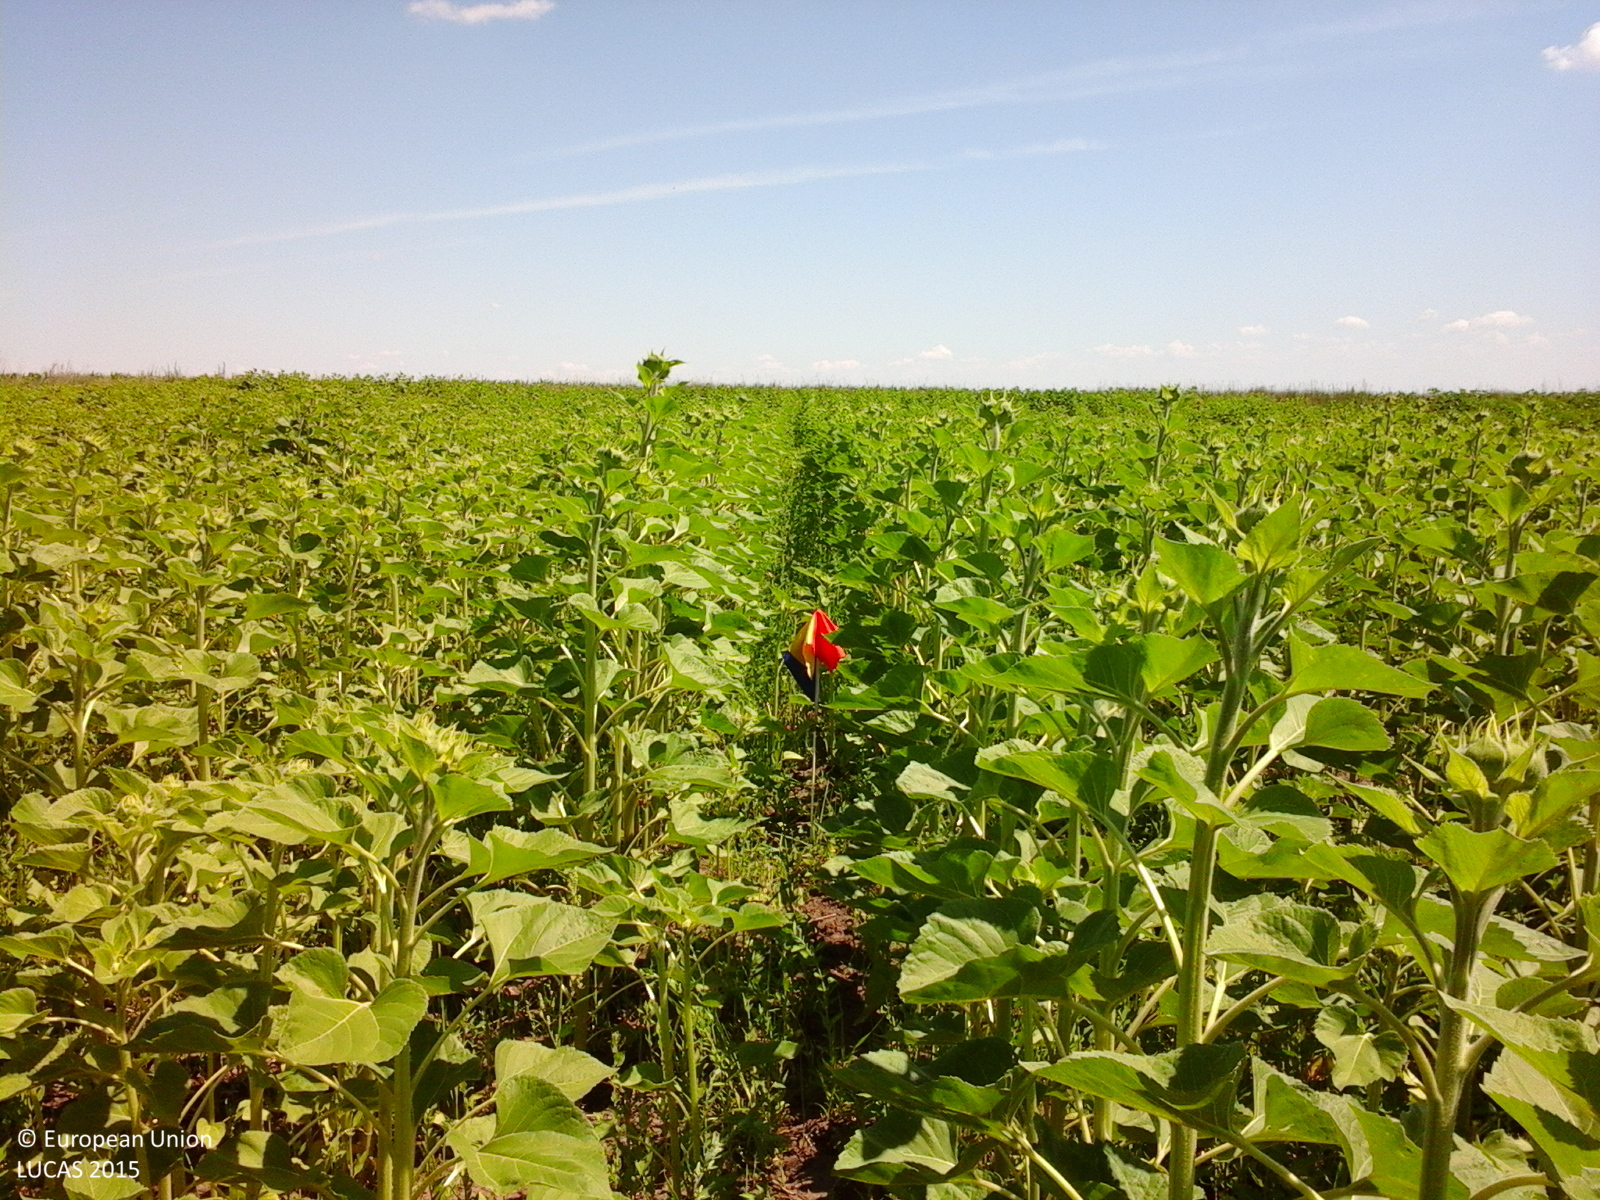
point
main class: Cropland
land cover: Sunflower
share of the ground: > 75 %
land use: Agriculture (excluding fallow land and kitchen gardens)
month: June
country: RO
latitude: 48.1784
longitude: 26.8746
